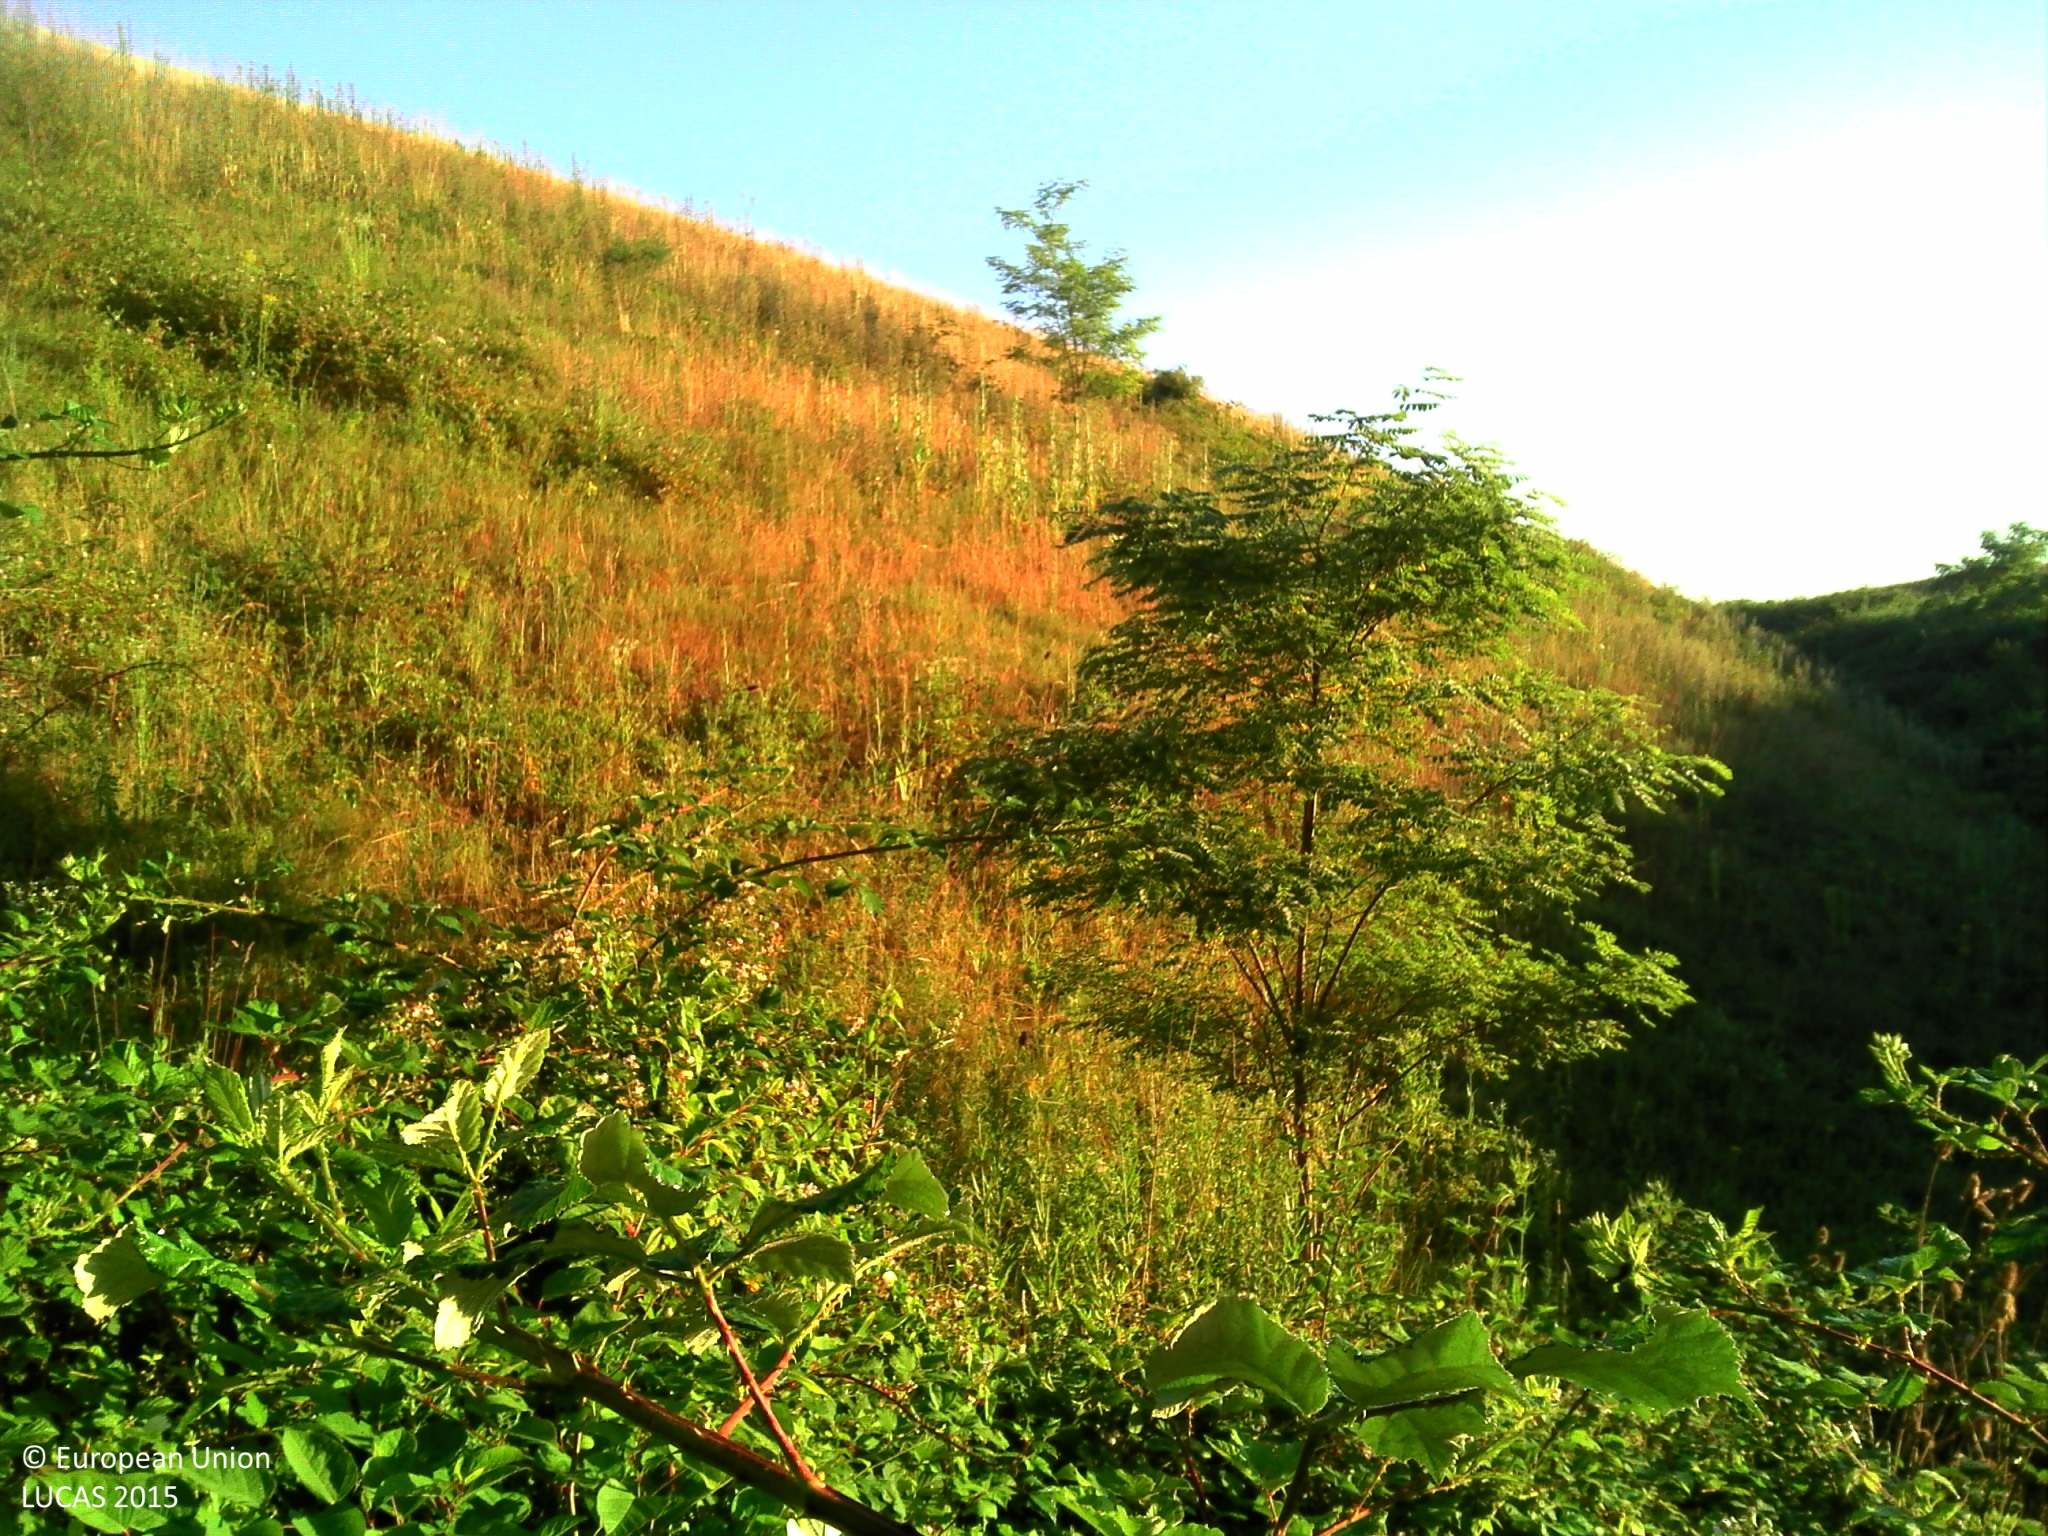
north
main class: Grassland
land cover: Spontaneously vegetated surfaces
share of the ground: > 75 %
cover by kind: herbaceous plants 95 %, shrubs 5 %
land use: Semi-natural and natural areas not in use
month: June
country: FR
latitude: 47.3966
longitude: 6.0665
